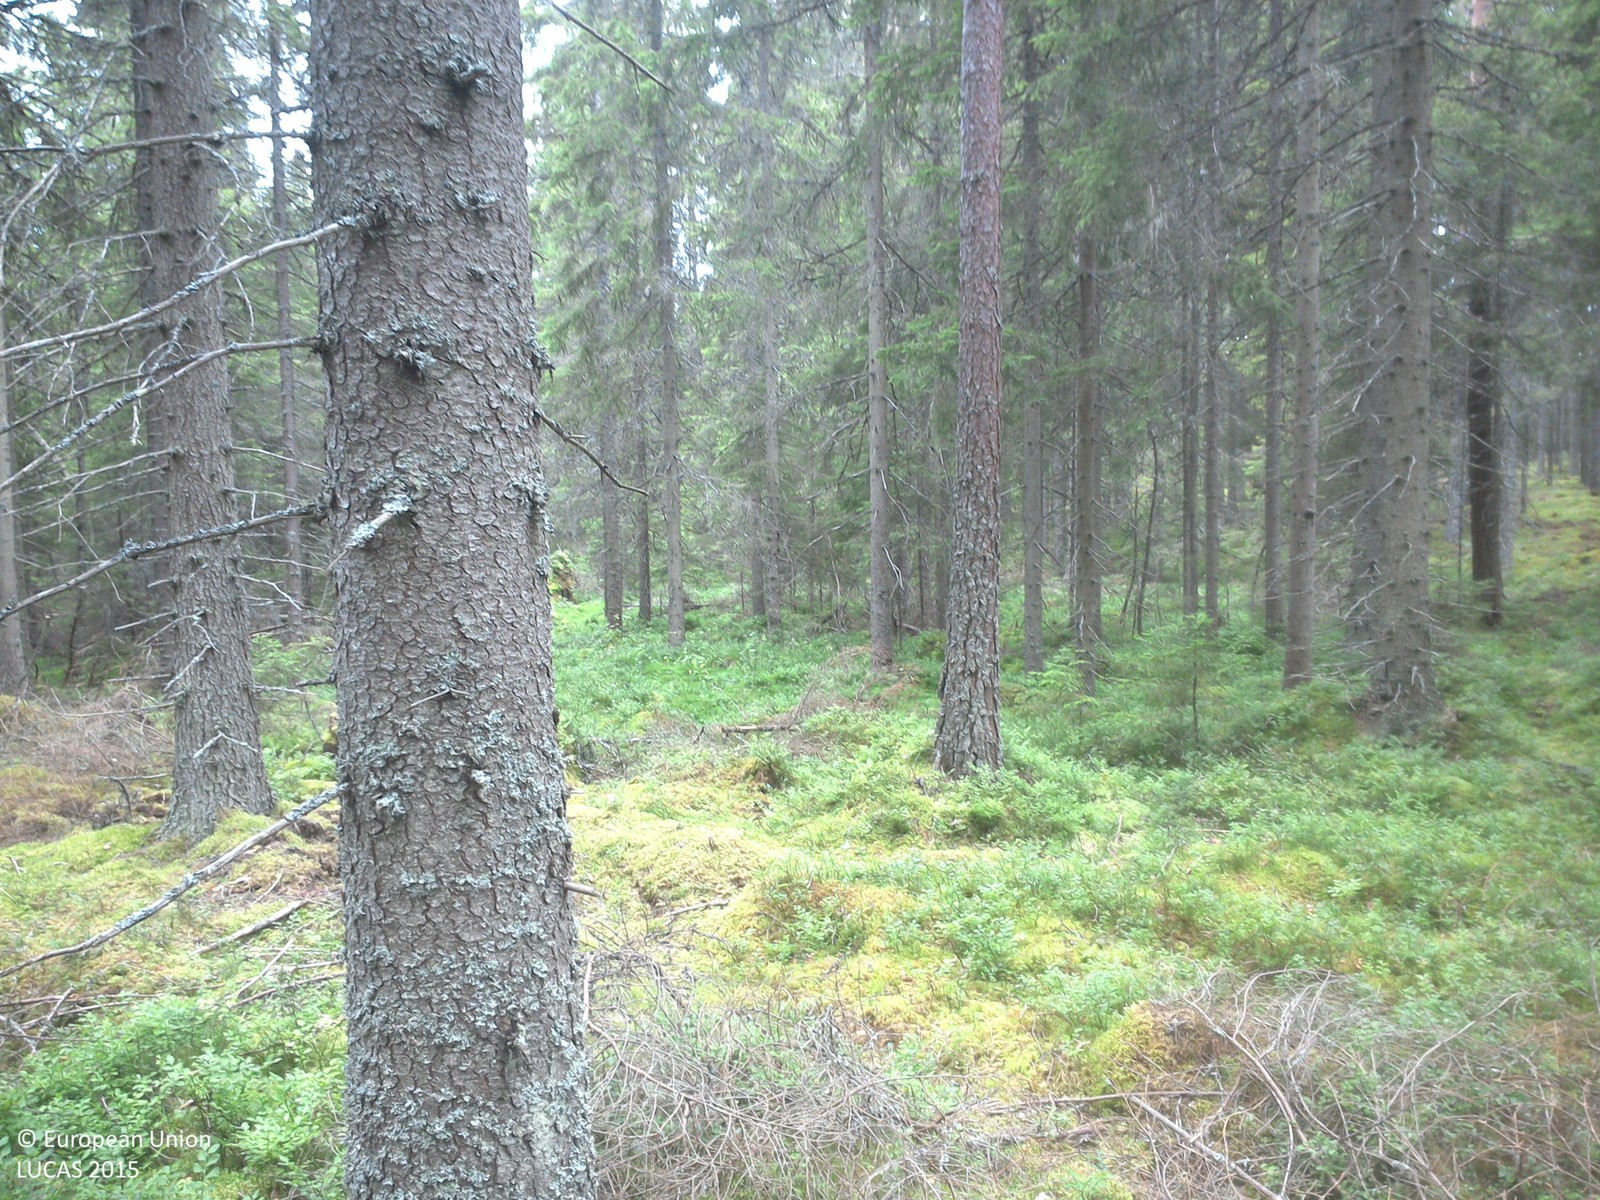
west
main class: Woodland
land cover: Spruce dominated coniferous woodland
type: boreal forest
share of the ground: 50 - 75 %
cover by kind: coniferous forest trees 65 %, lichens and mosses 25 %, herbaceous plants 10 %
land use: Forestry
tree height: > 5 m
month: August
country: SE
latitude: 57.7536
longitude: 15.3227
